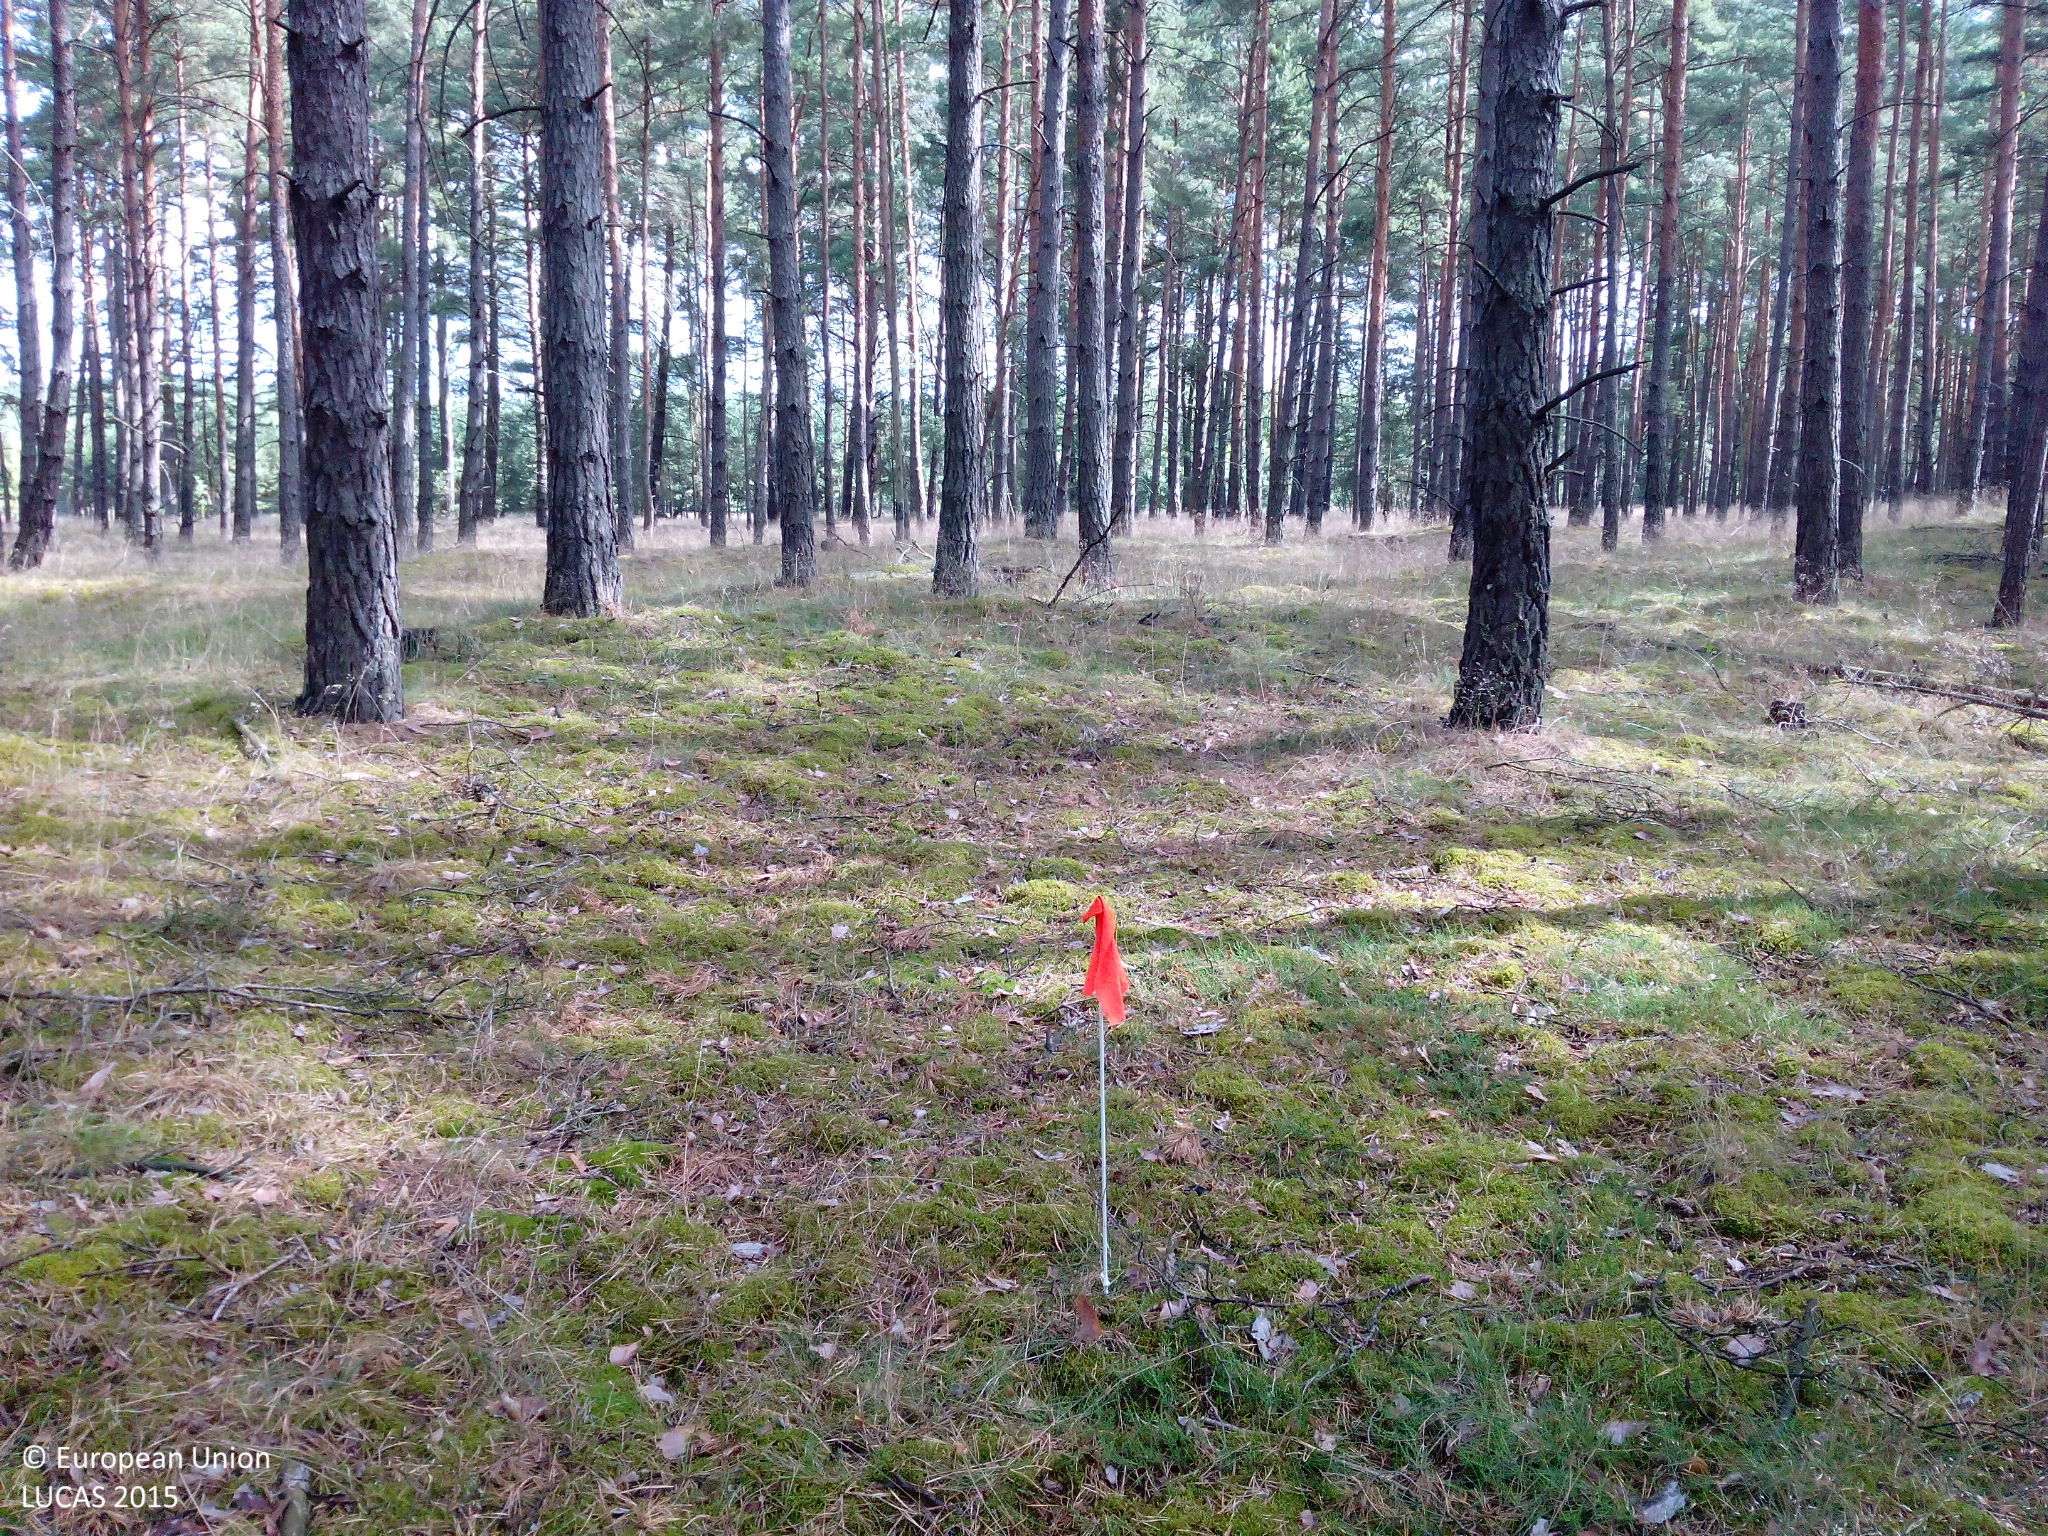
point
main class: Woodland
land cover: Pine dominated coniferous woodland
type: hemiboreal forest and nemoral coniferous forest and mixed broadleaved-coniferous forest
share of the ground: > 75 %
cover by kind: coniferous forest trees 80 %, herbaceous plants 10 %, lichens and mosses 10 %
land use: Forestry
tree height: > 5 m
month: July
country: DE
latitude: 52.8103
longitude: 13.5458
